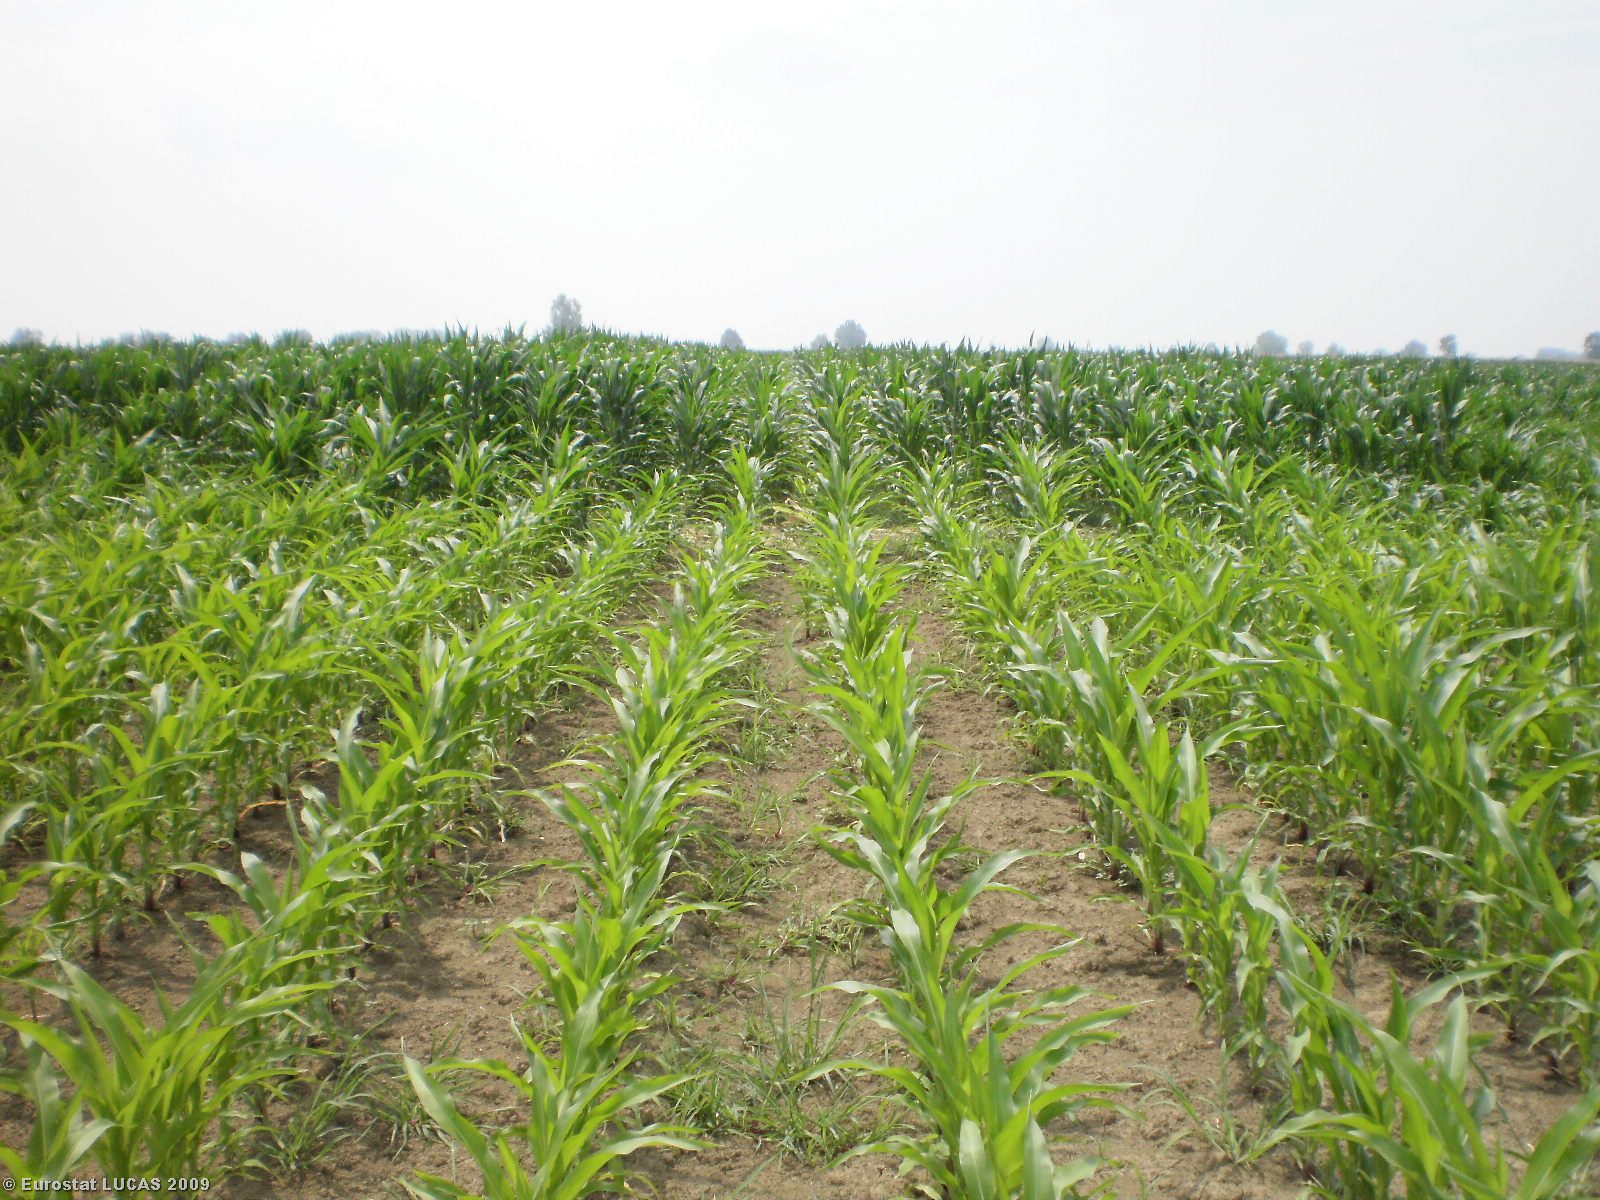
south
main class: Cropland
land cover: Maize
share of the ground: > 75 %
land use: Agriculture (excluding fallow land and kitchen gardens)
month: June
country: IT
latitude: 45.0715
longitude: 10.2662
